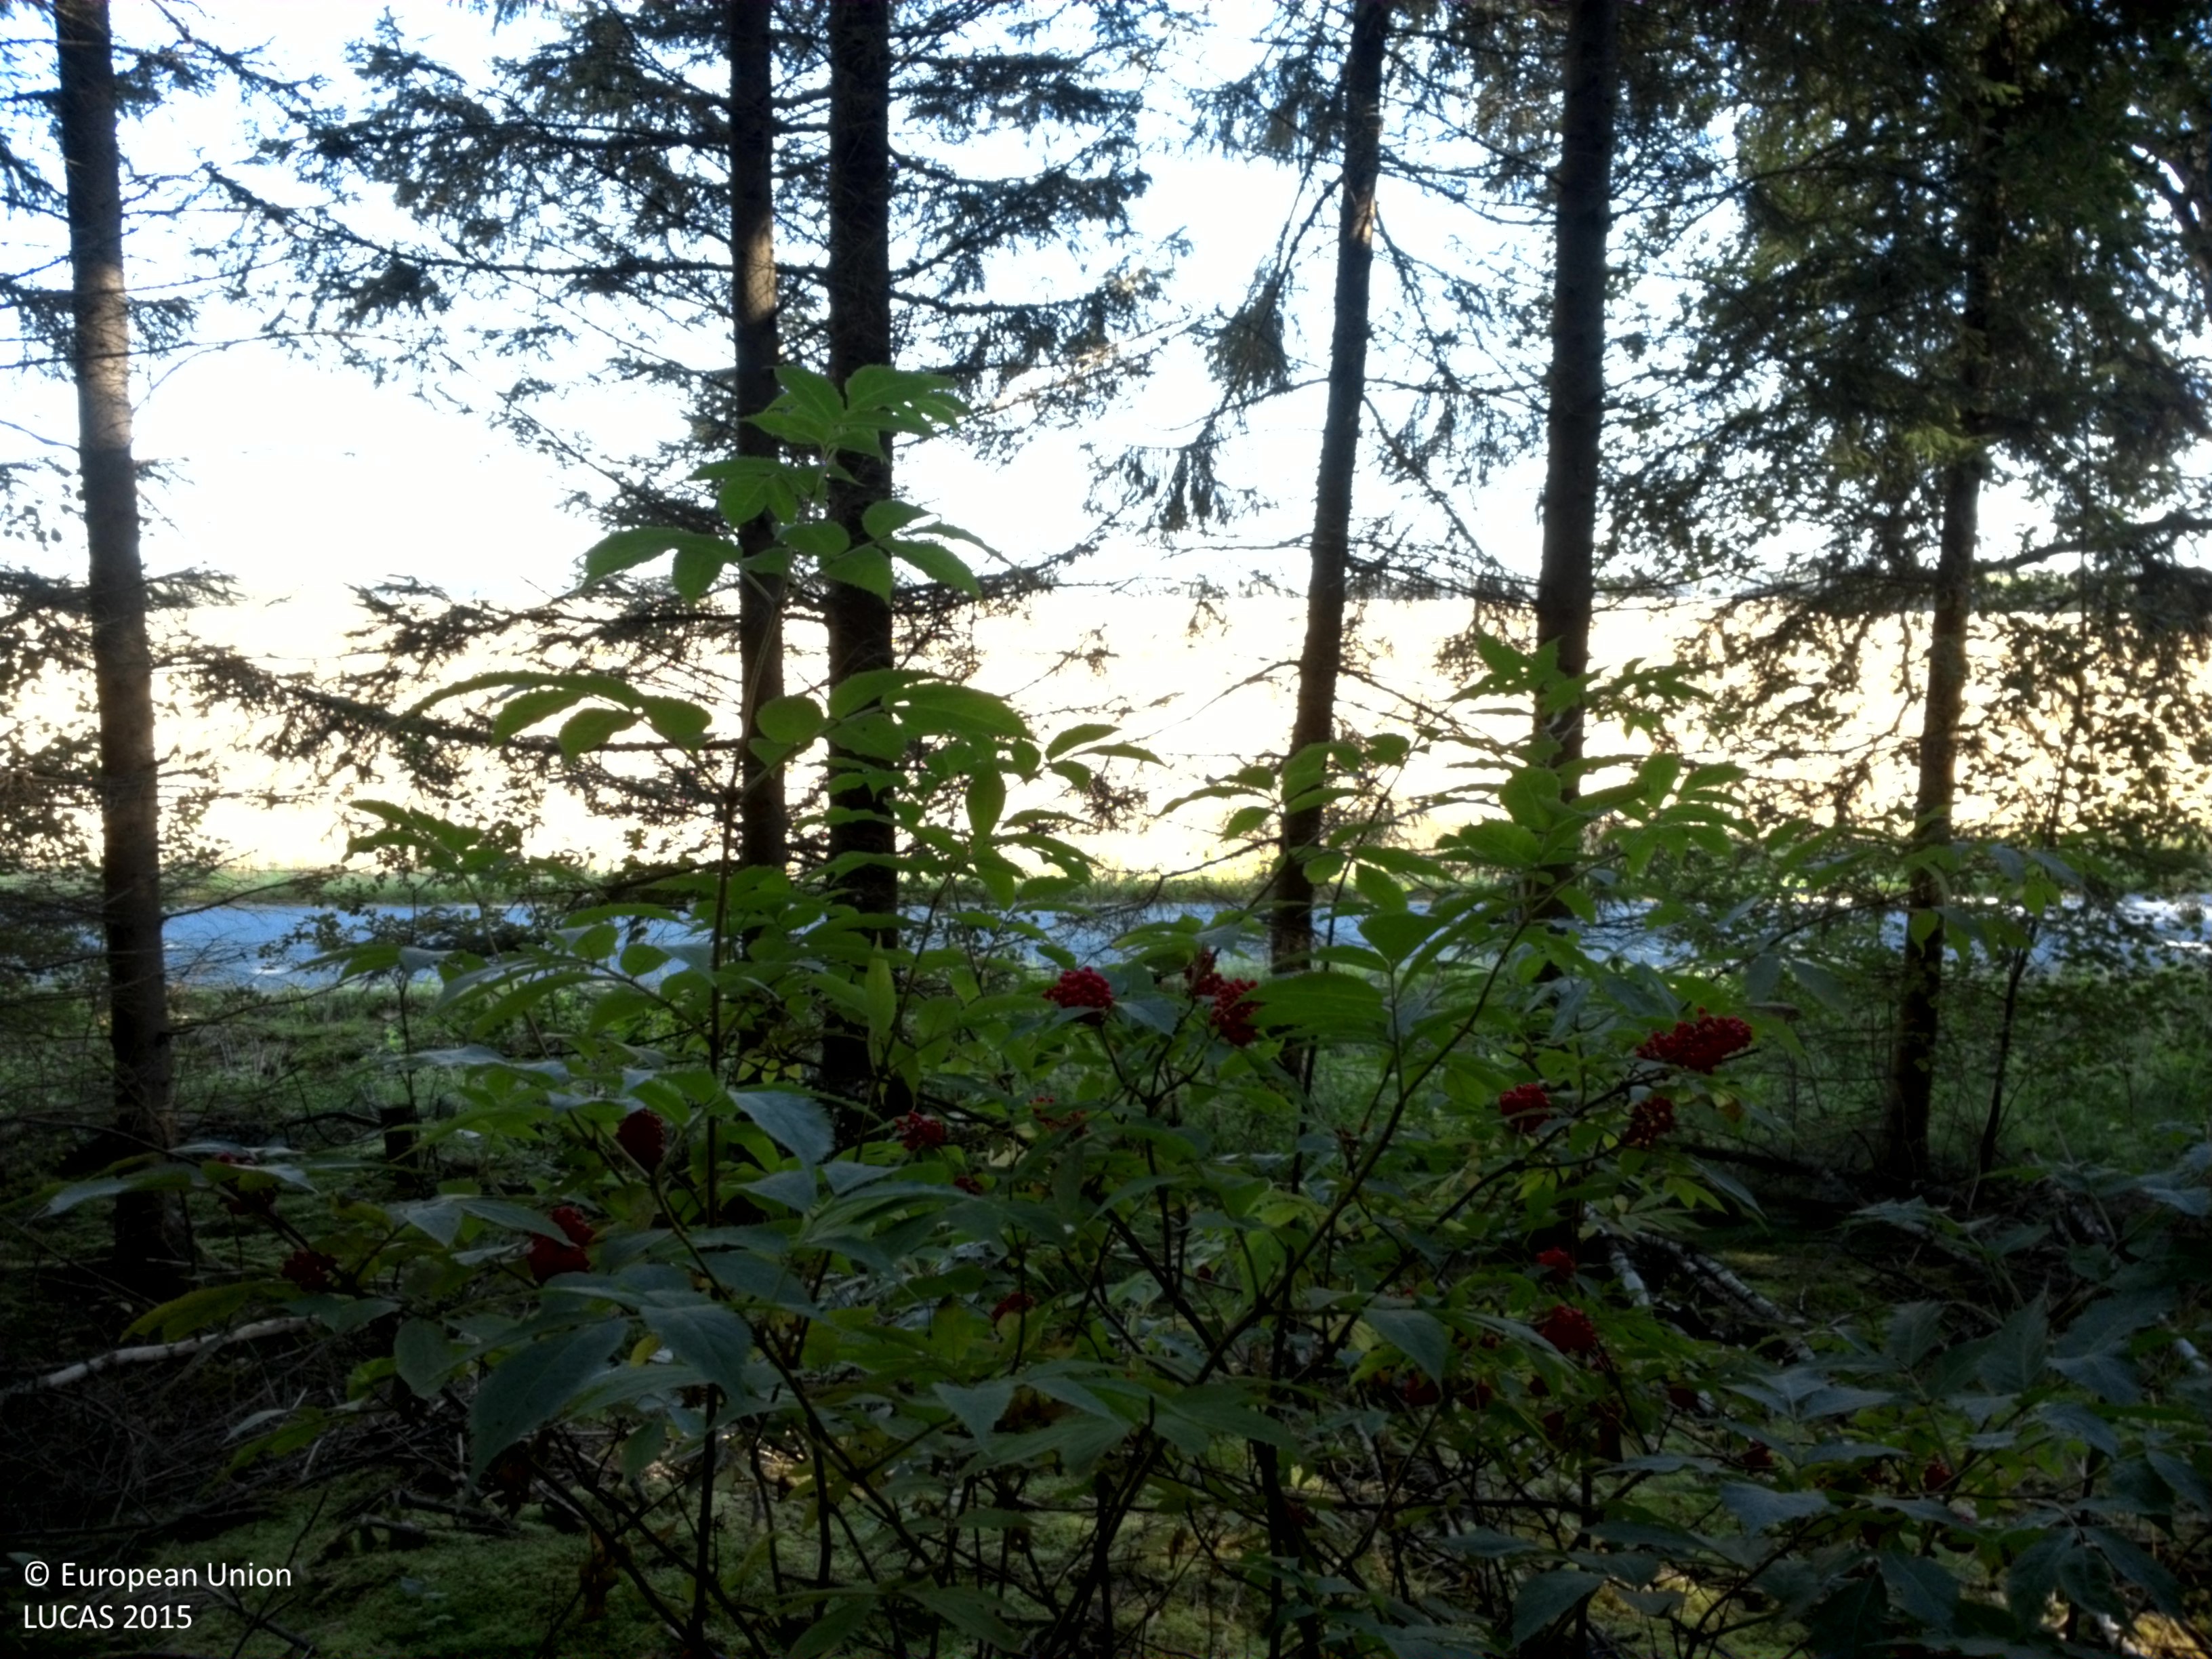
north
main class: Woodland
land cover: Spruce dominated coniferous woodland
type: boreal forest
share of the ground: > 75 %
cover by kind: coniferous forest trees 90 %, herbaceous plants 5 %, lichens and mosses 5 %
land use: Forestry
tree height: > 5 m
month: August
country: SE
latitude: 59.6036
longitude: 17.4544
